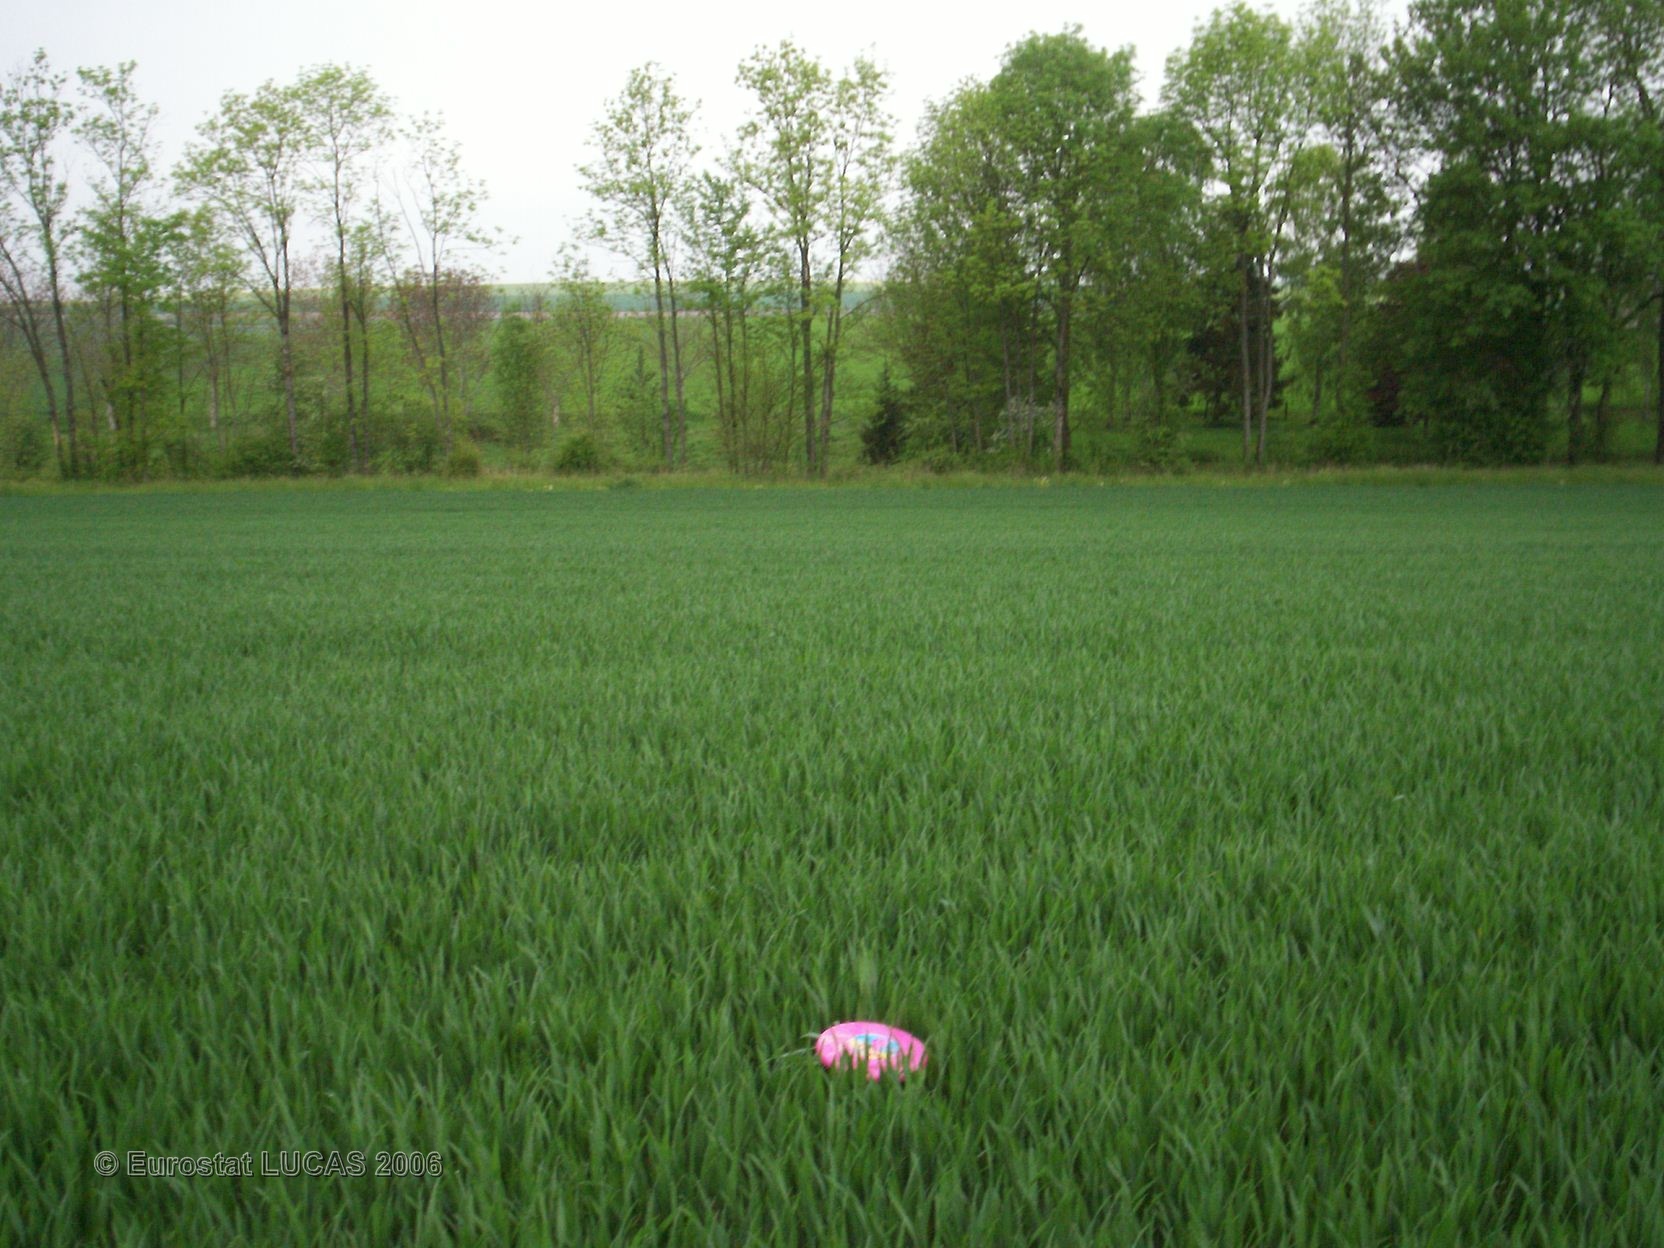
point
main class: Cropland
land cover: Common wheat
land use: Agriculture (excluding fallow land and kitchen gardens)
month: May
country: FR
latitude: 49.5212
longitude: 4.3459
